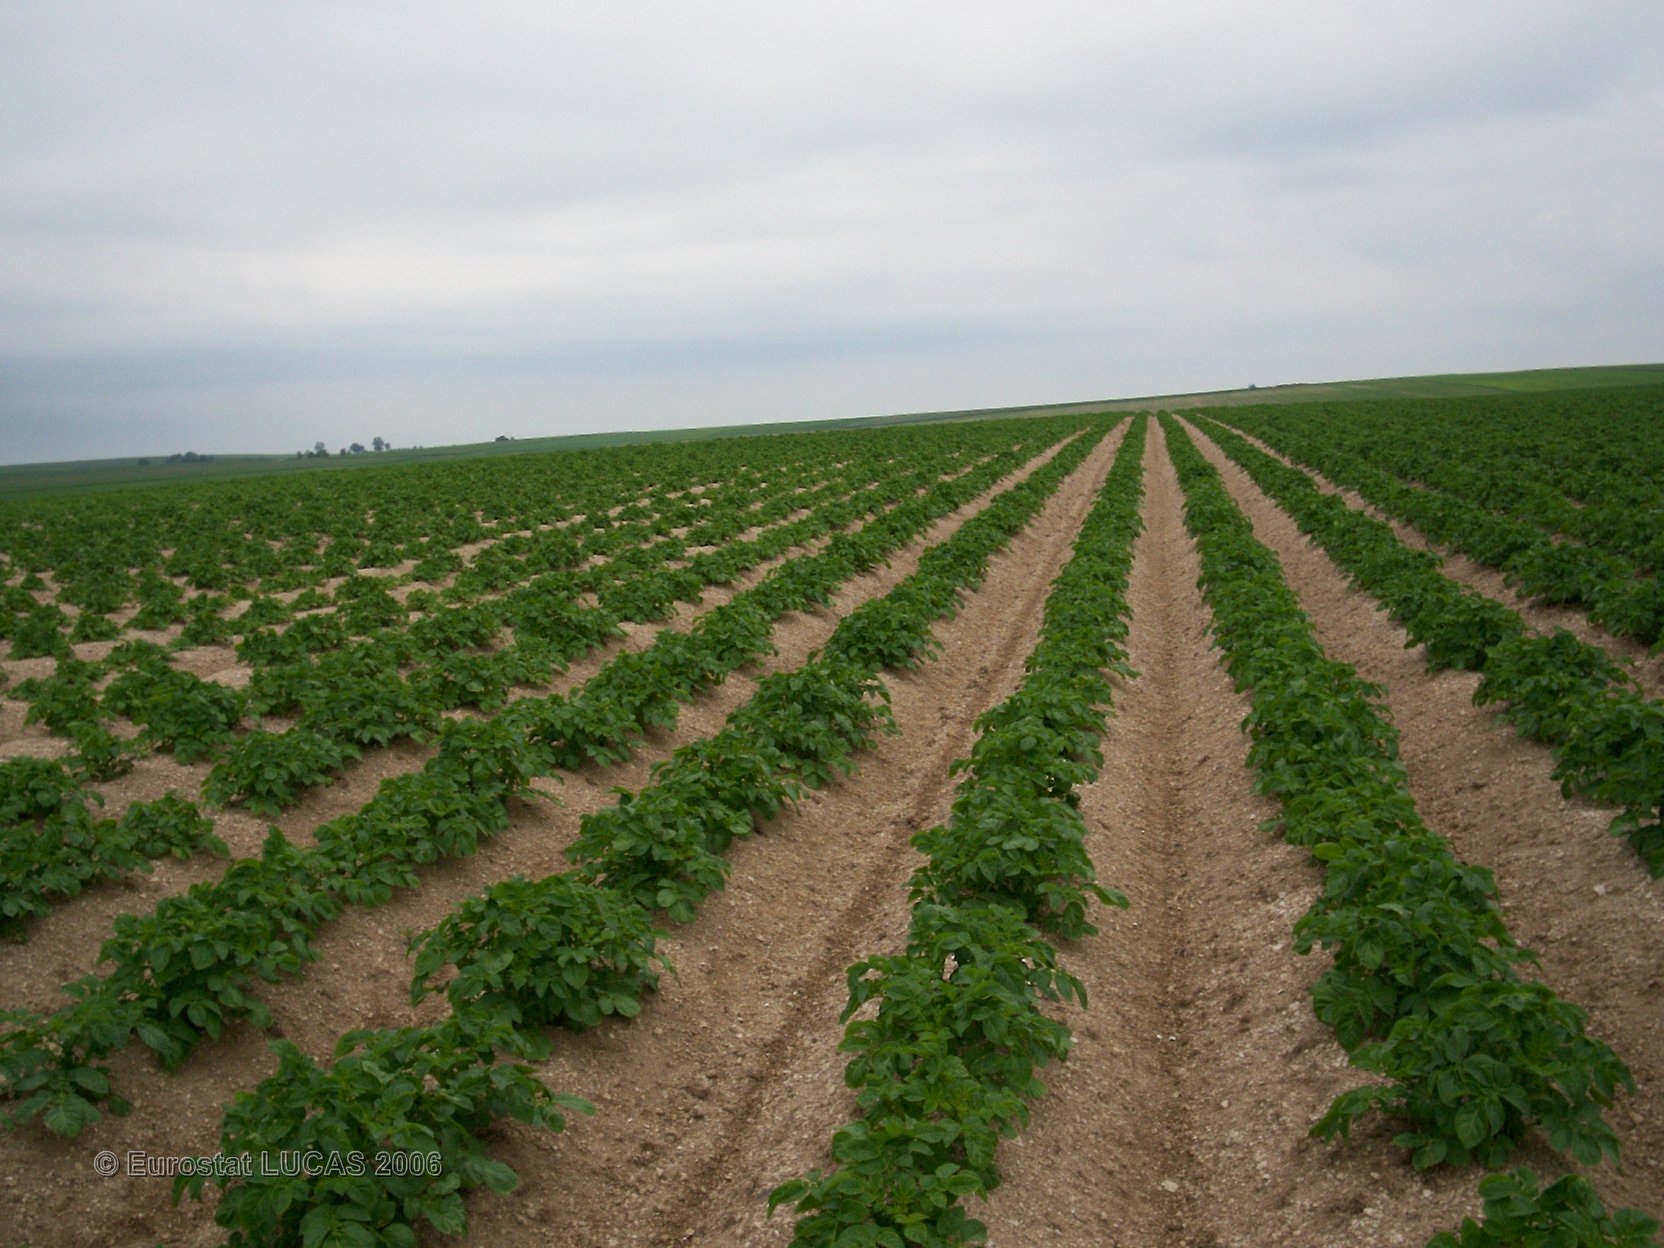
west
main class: Cropland
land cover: Potatoes
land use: Agriculture (excluding fallow land and kitchen gardens)
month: June
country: FR
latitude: 48.7502
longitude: 4.4340
